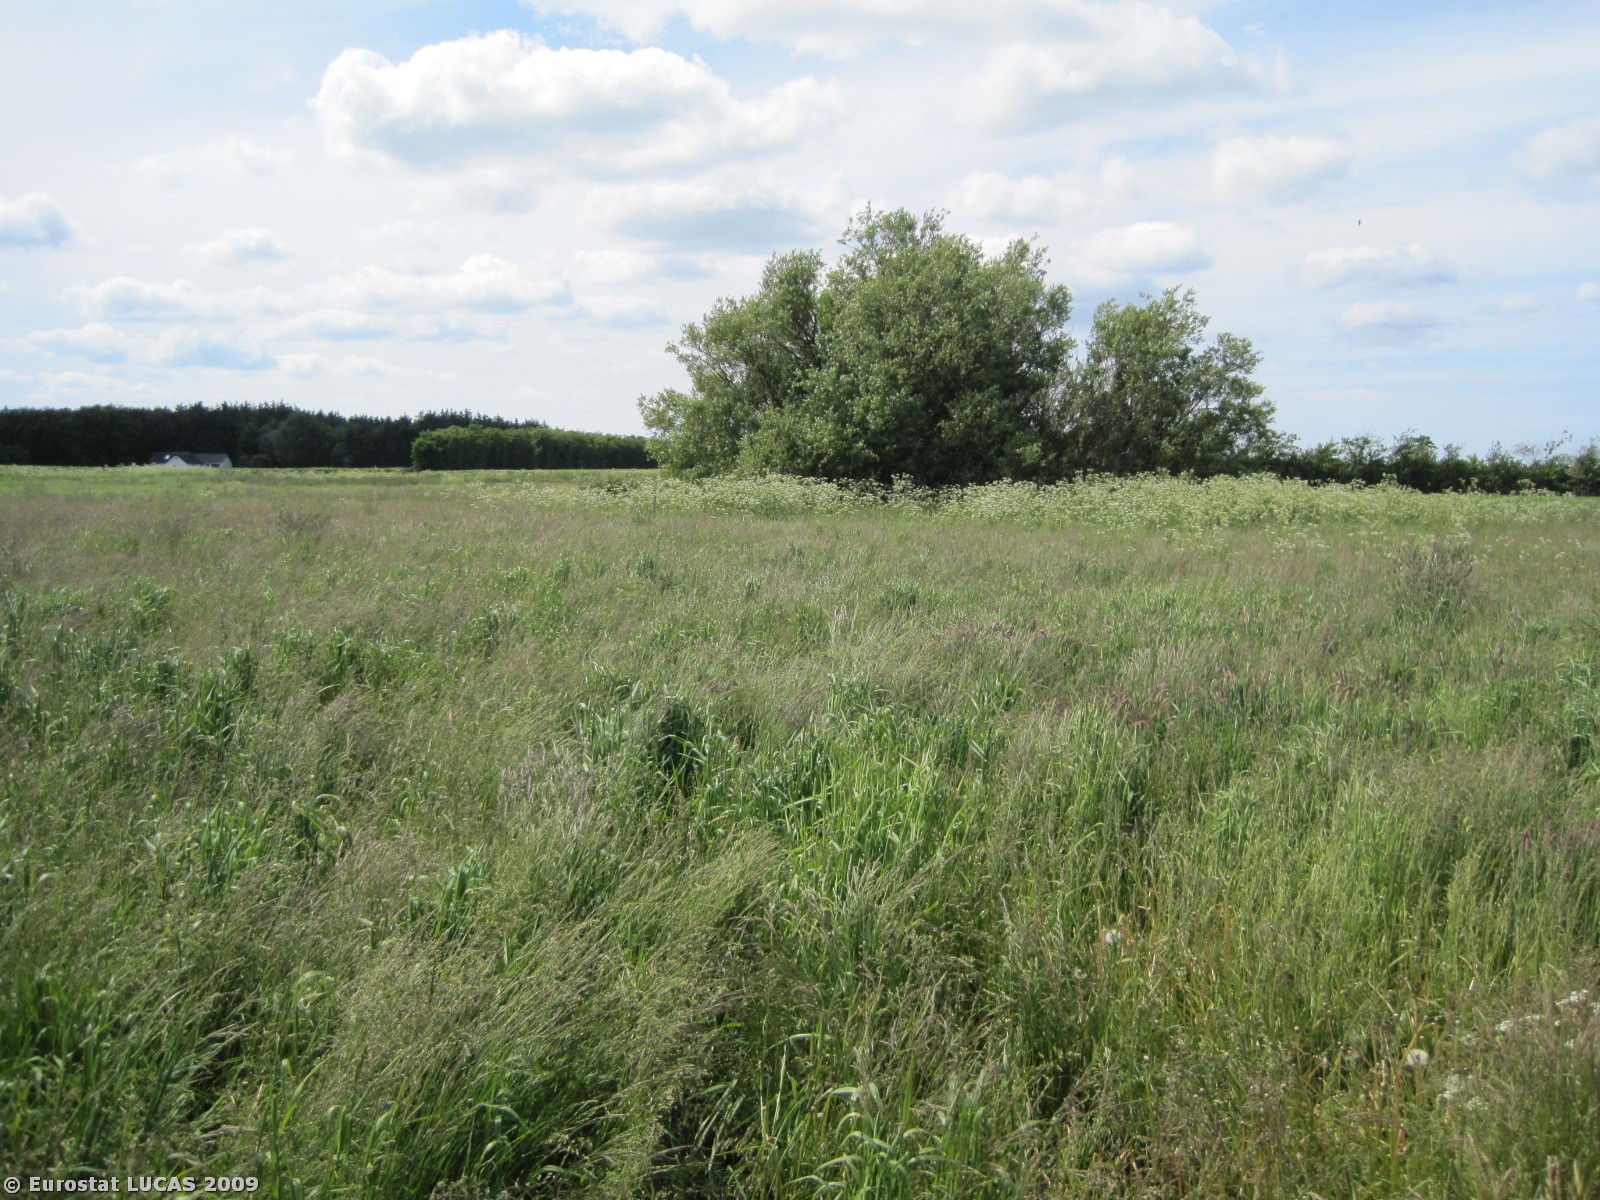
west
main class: Grassland
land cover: Grassland without tree/shrub cover
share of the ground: > 75 %
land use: Unused
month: June
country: DK
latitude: 57.3742
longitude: 9.8838
